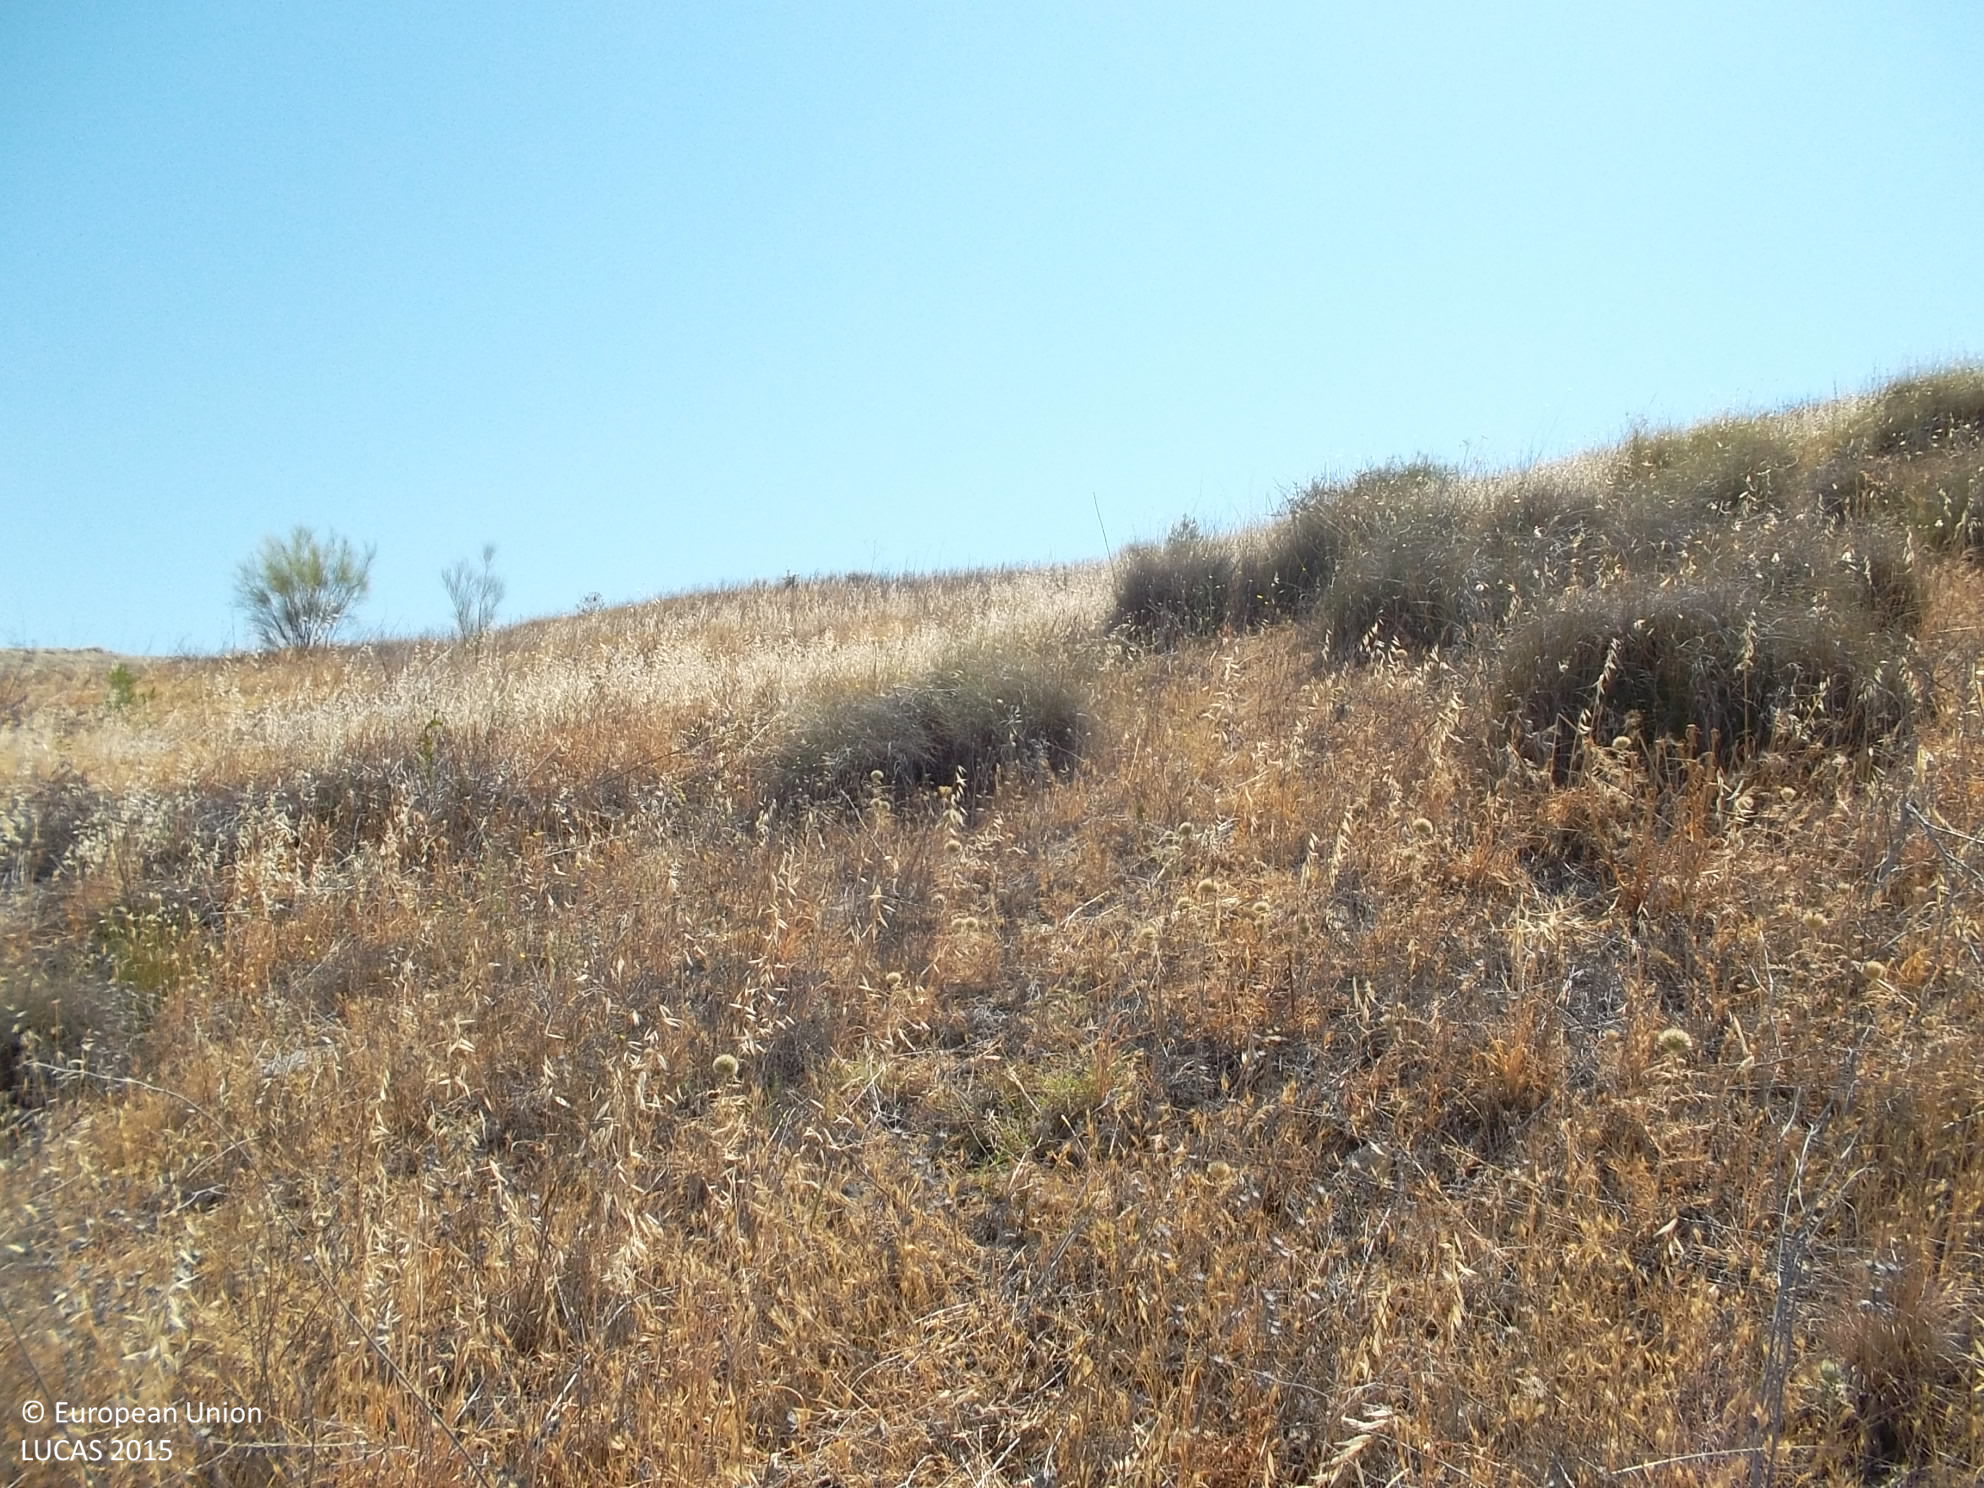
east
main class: Grassland
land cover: Grassland with sparse tree/shrub cover
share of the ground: 50 - 75 %
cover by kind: herbaceous plants 85 %, shrubs 10 %, broadleaved forest trees 5 %
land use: Semi-natural and natural areas not in use
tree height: < 5 m
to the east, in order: Grassland with sparse tree/shrub cover; Other bare soil
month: June
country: ES
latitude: 37.8306
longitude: -3.2096
